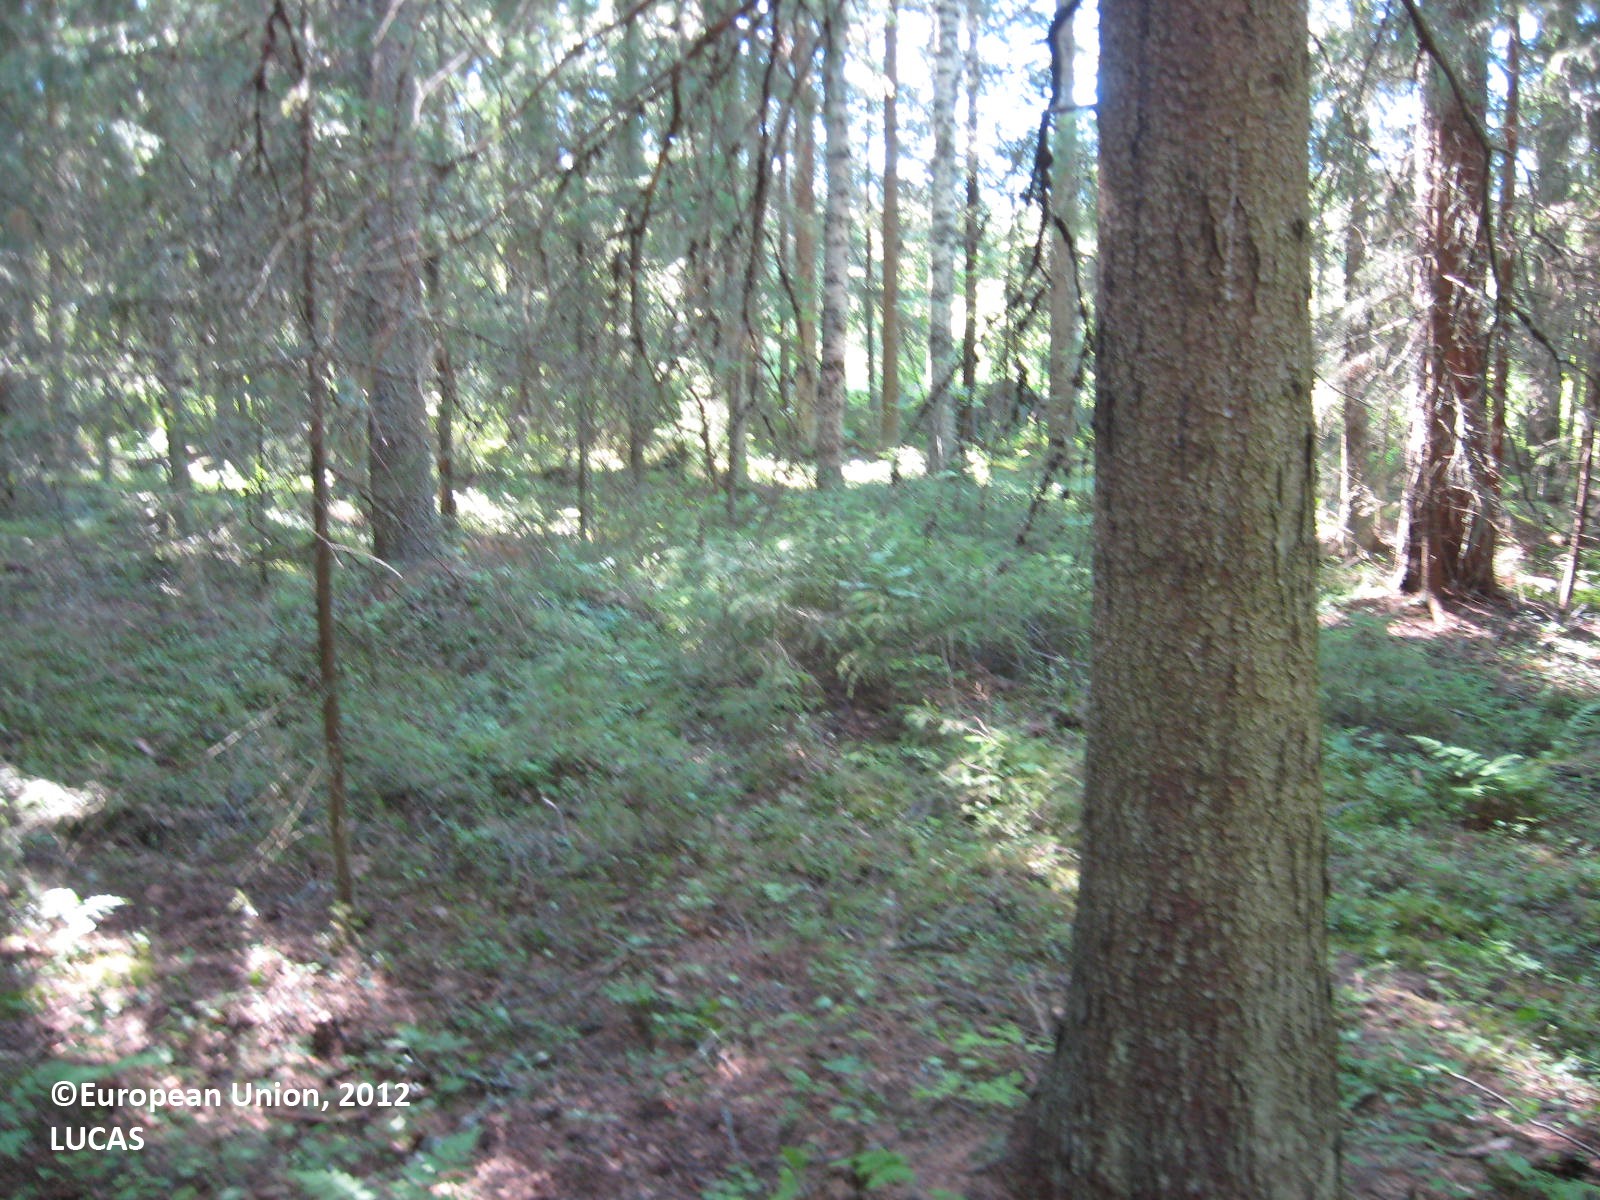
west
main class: Woodland
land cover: Spruce dominated coniferous woodland
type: boreal forest
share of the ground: > 75 %
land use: Forestry
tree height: > 5 m
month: July
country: FI
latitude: 62.1933
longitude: 21.6730
